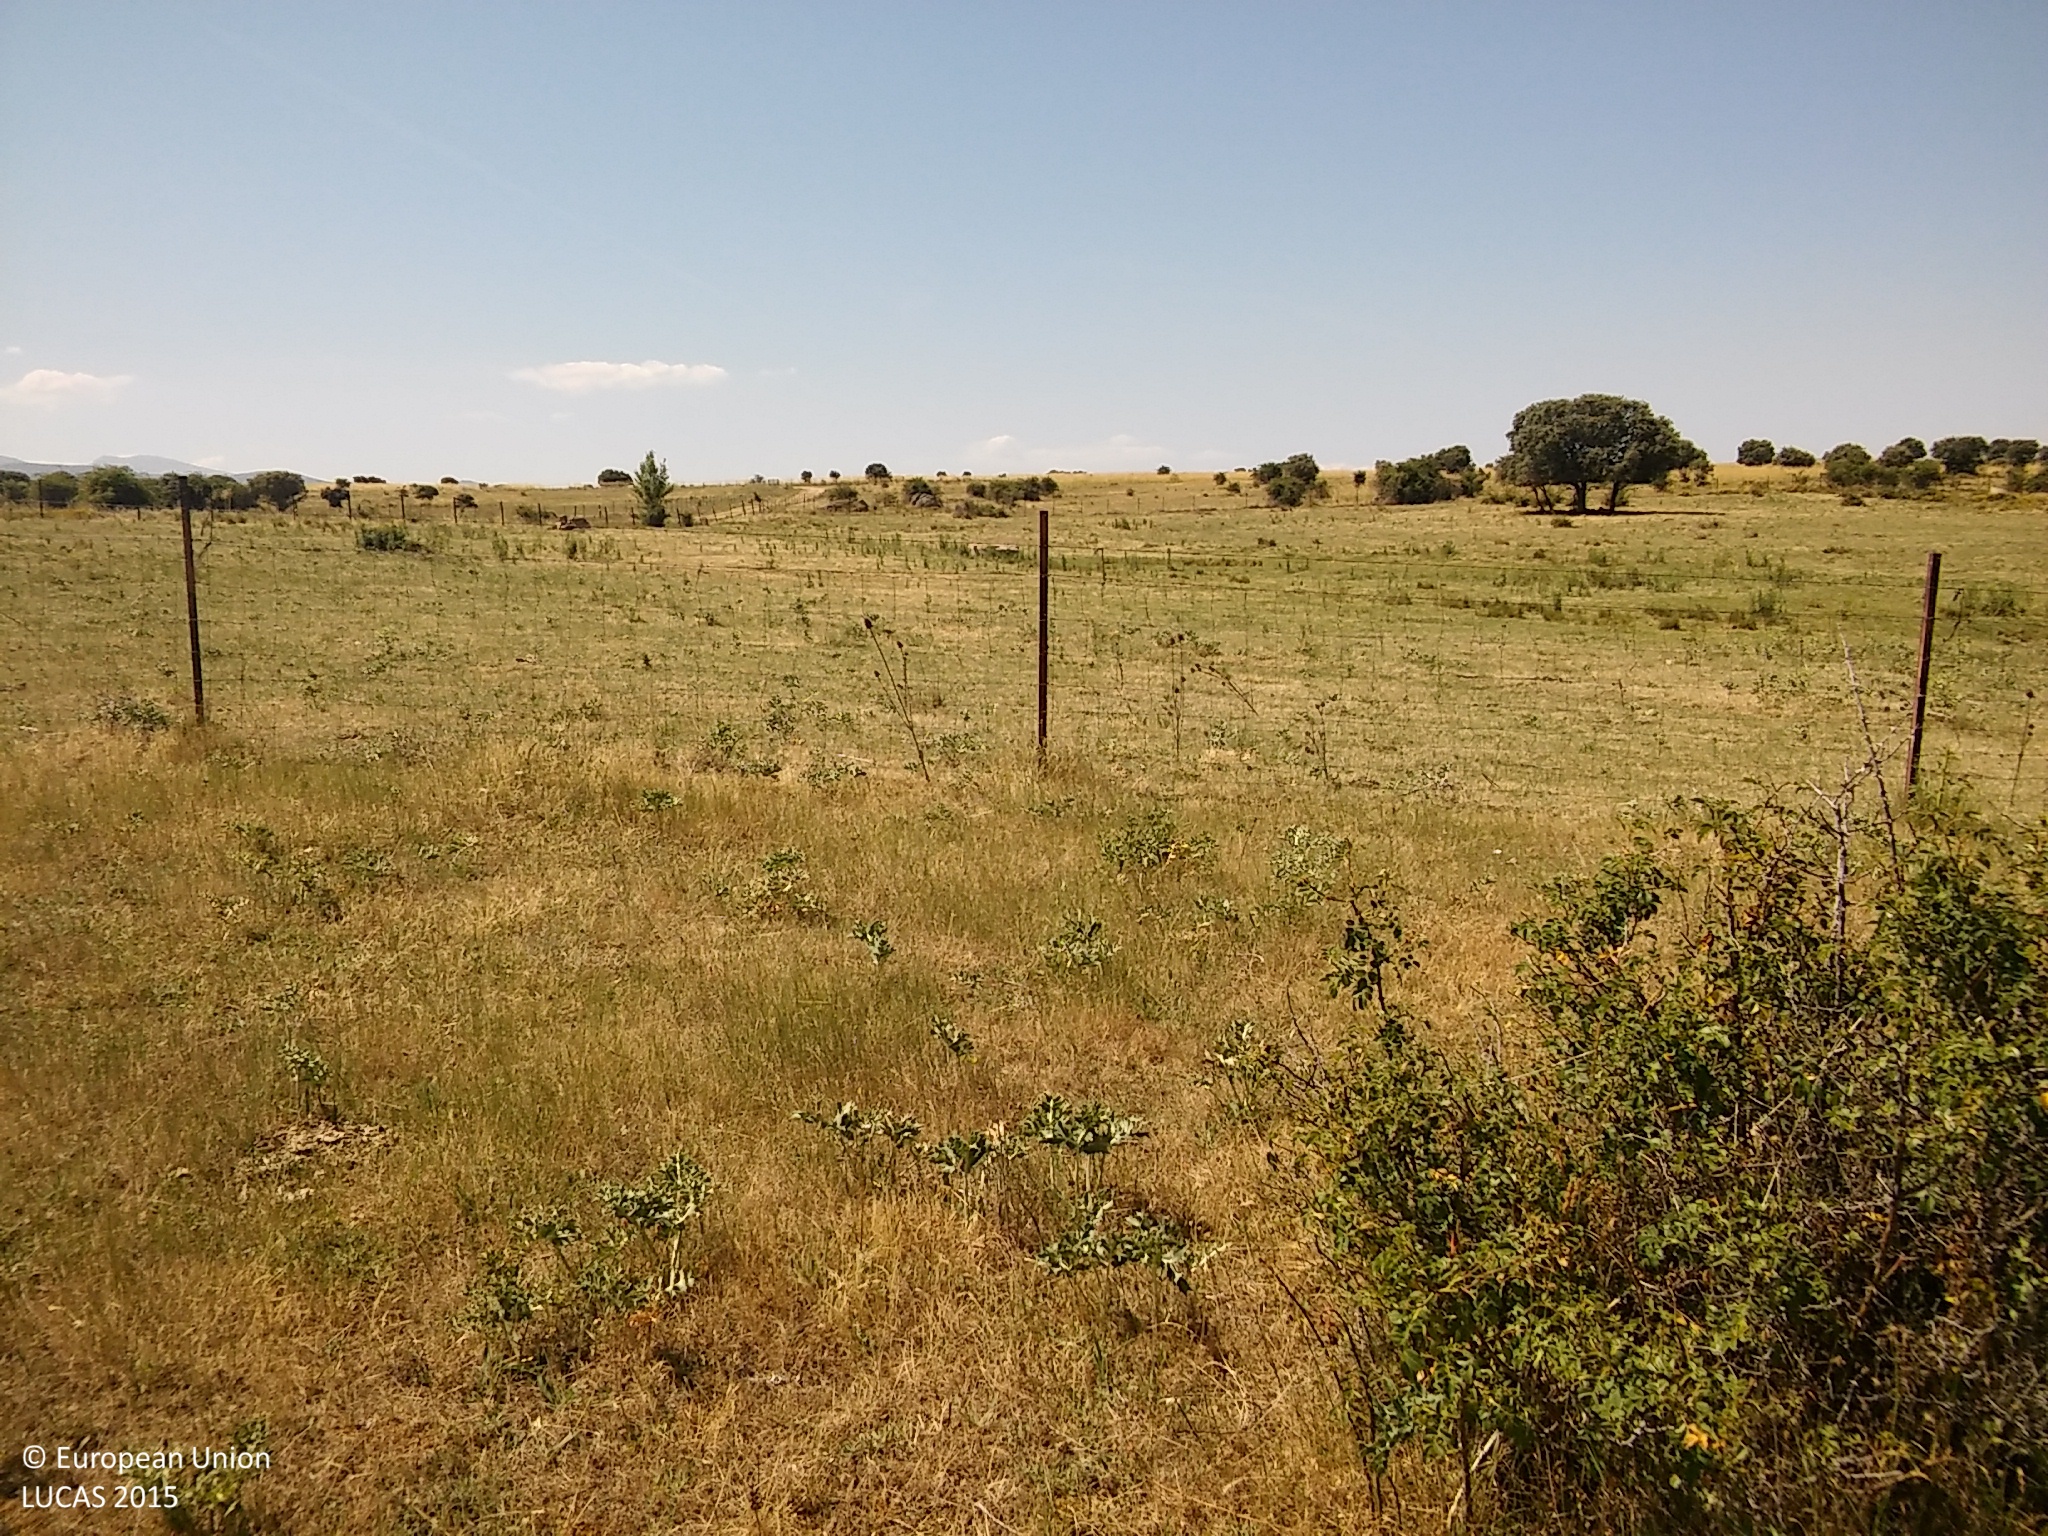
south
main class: Shrubland
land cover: Shrubland without tree cover
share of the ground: 25 - 50 %
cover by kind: herbaceous plants 75 %, shrubs 25 %
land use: Agriculture (excluding fallow land and kitchen gardens)
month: June
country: ES
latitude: 41.0529
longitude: -4.0063
